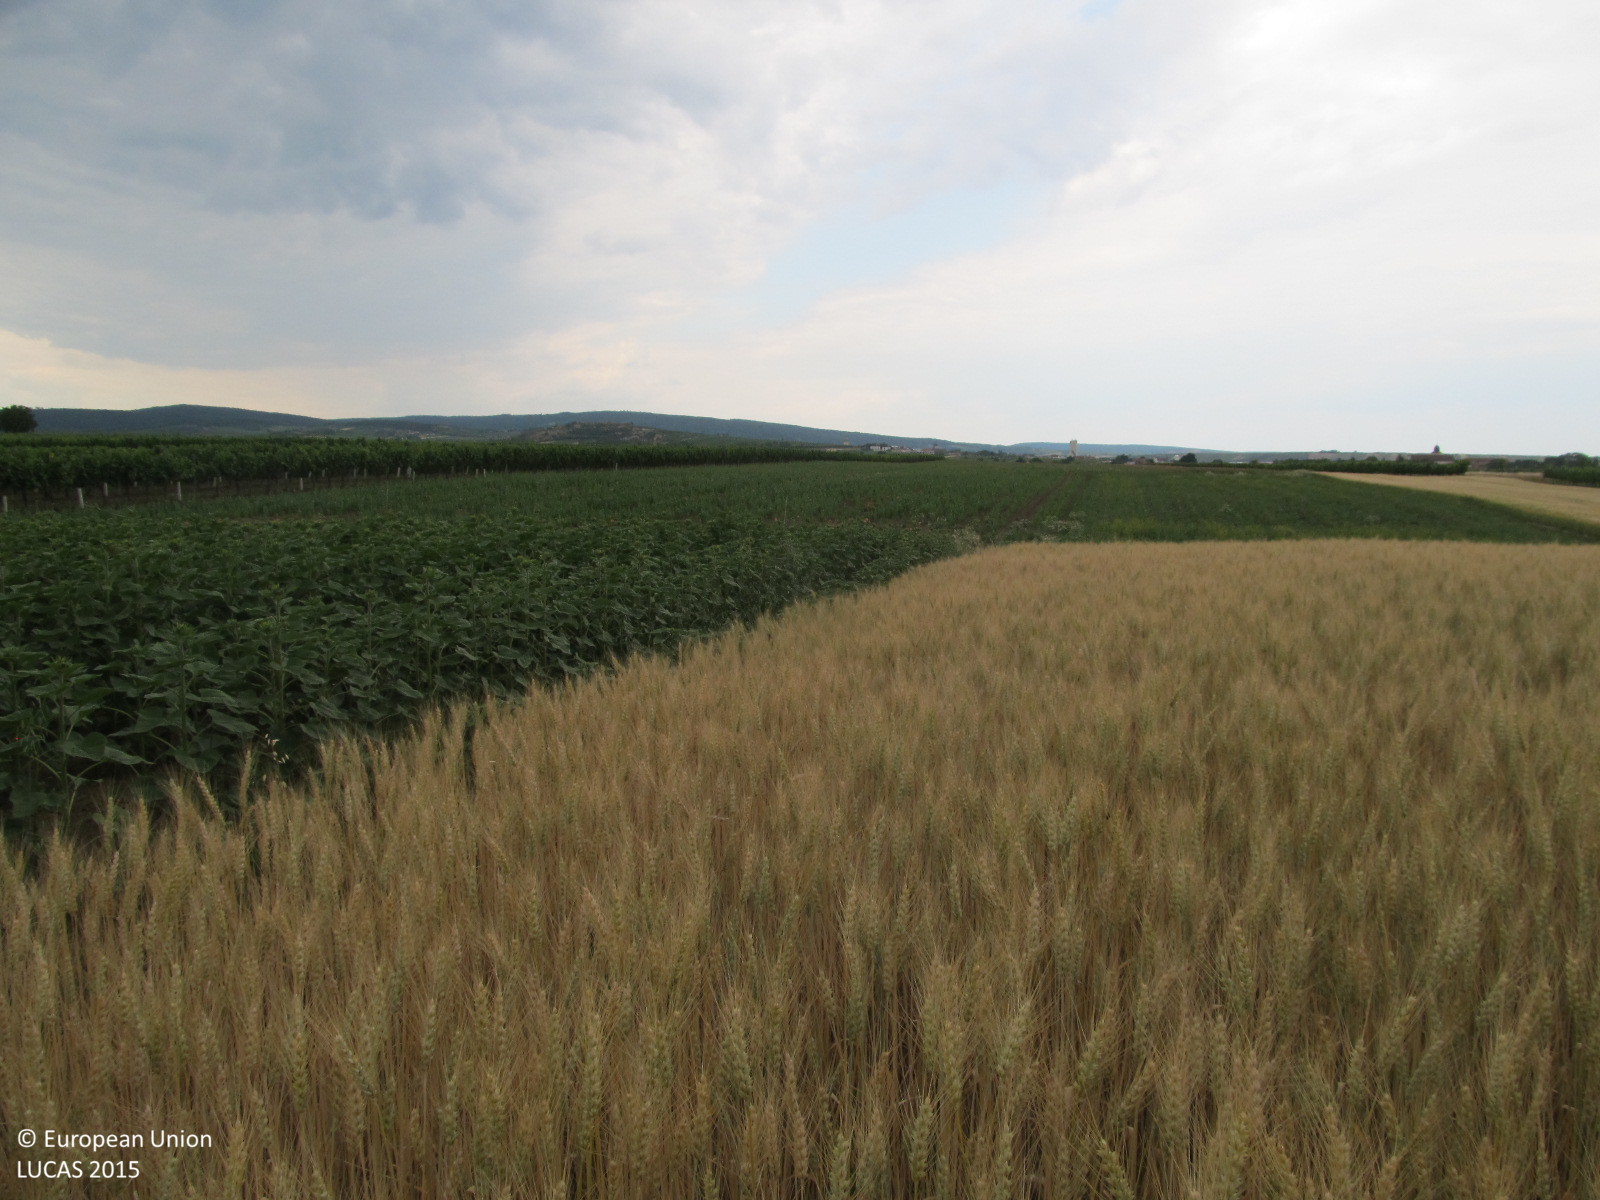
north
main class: Cropland
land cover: Common wheat
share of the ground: > 75 %
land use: Agriculture (excluding fallow land and kitchen gardens)
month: June
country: AT
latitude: 48.7306
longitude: 15.9456
